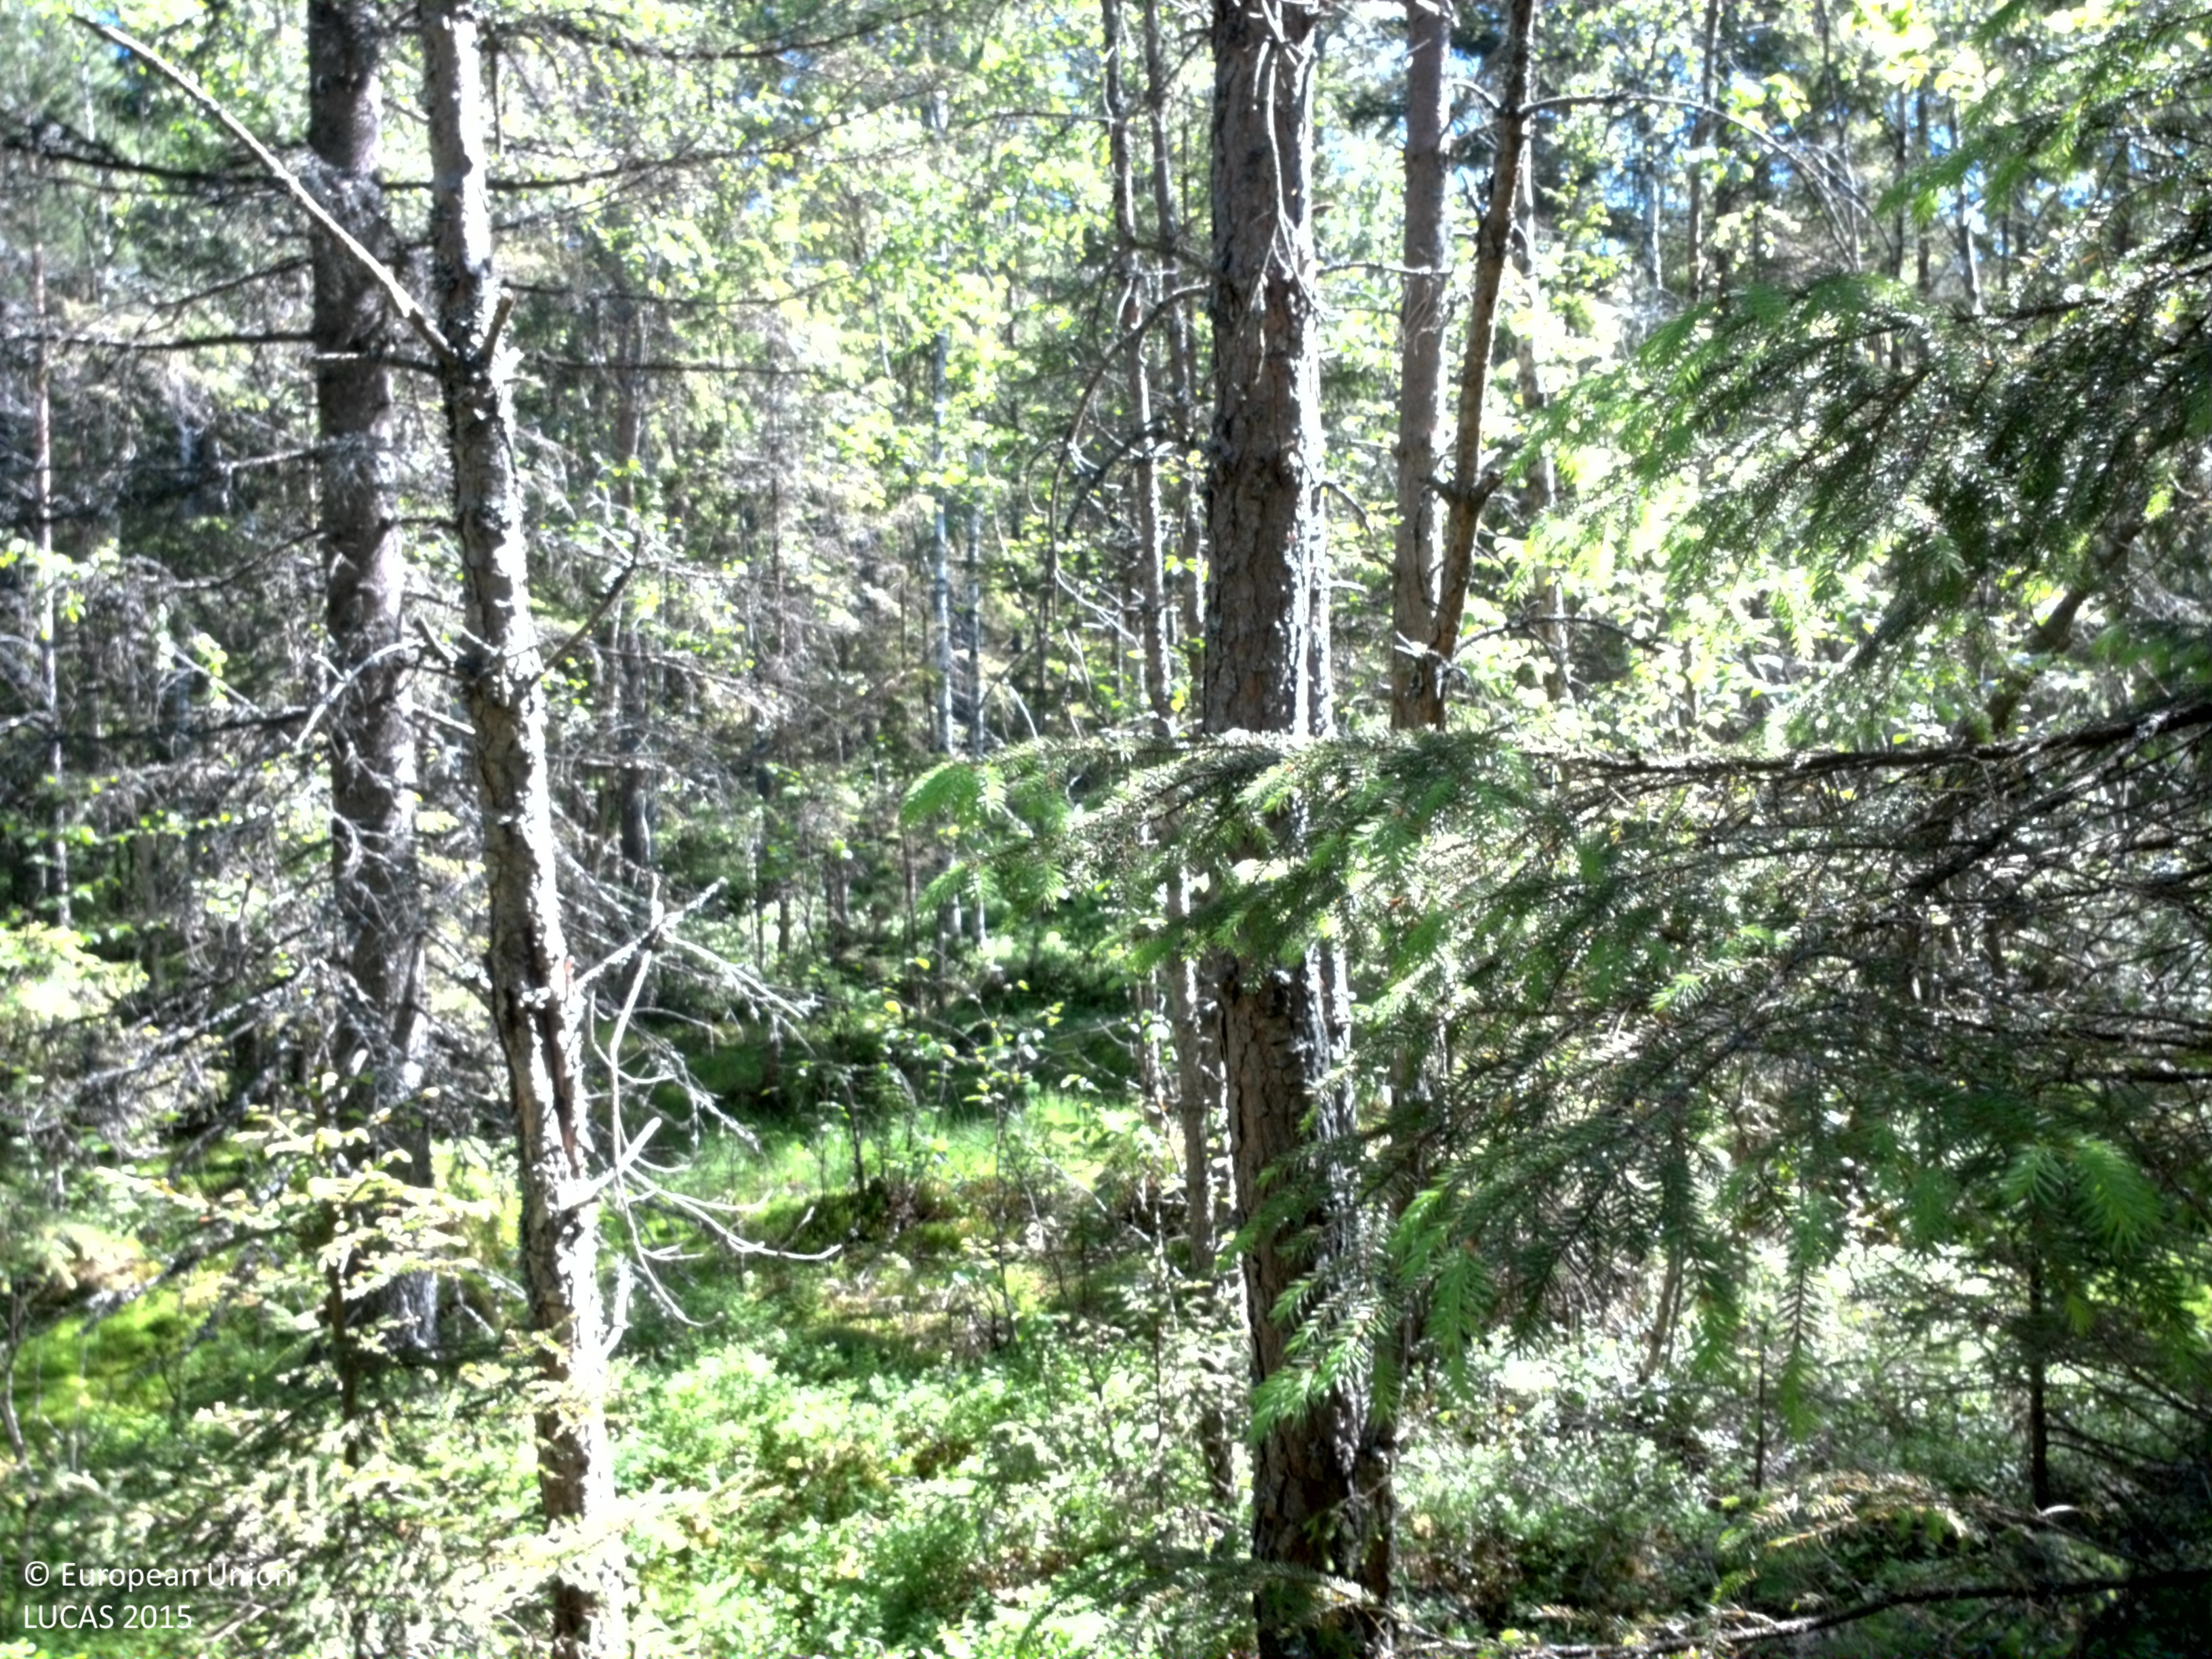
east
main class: Woodland
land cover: Spruce dominated mixed woodland
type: boreal forest
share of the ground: 50 - 75 %
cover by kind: coniferous forest trees 40 %, shrubs 20 %, broadleaved forest trees 15 %, lichens and mosses 15 %, herbaceous plants 10 %
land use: Forestry
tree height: > 5 m
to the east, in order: Spruce dominated mixed woodland; Pine dominated coniferous woodland; Electric lines; Pine dominated mixed woodland; Tracks; Spruce dominated coniferous woodland
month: June
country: SE
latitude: 59.5184
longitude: 11.9919
